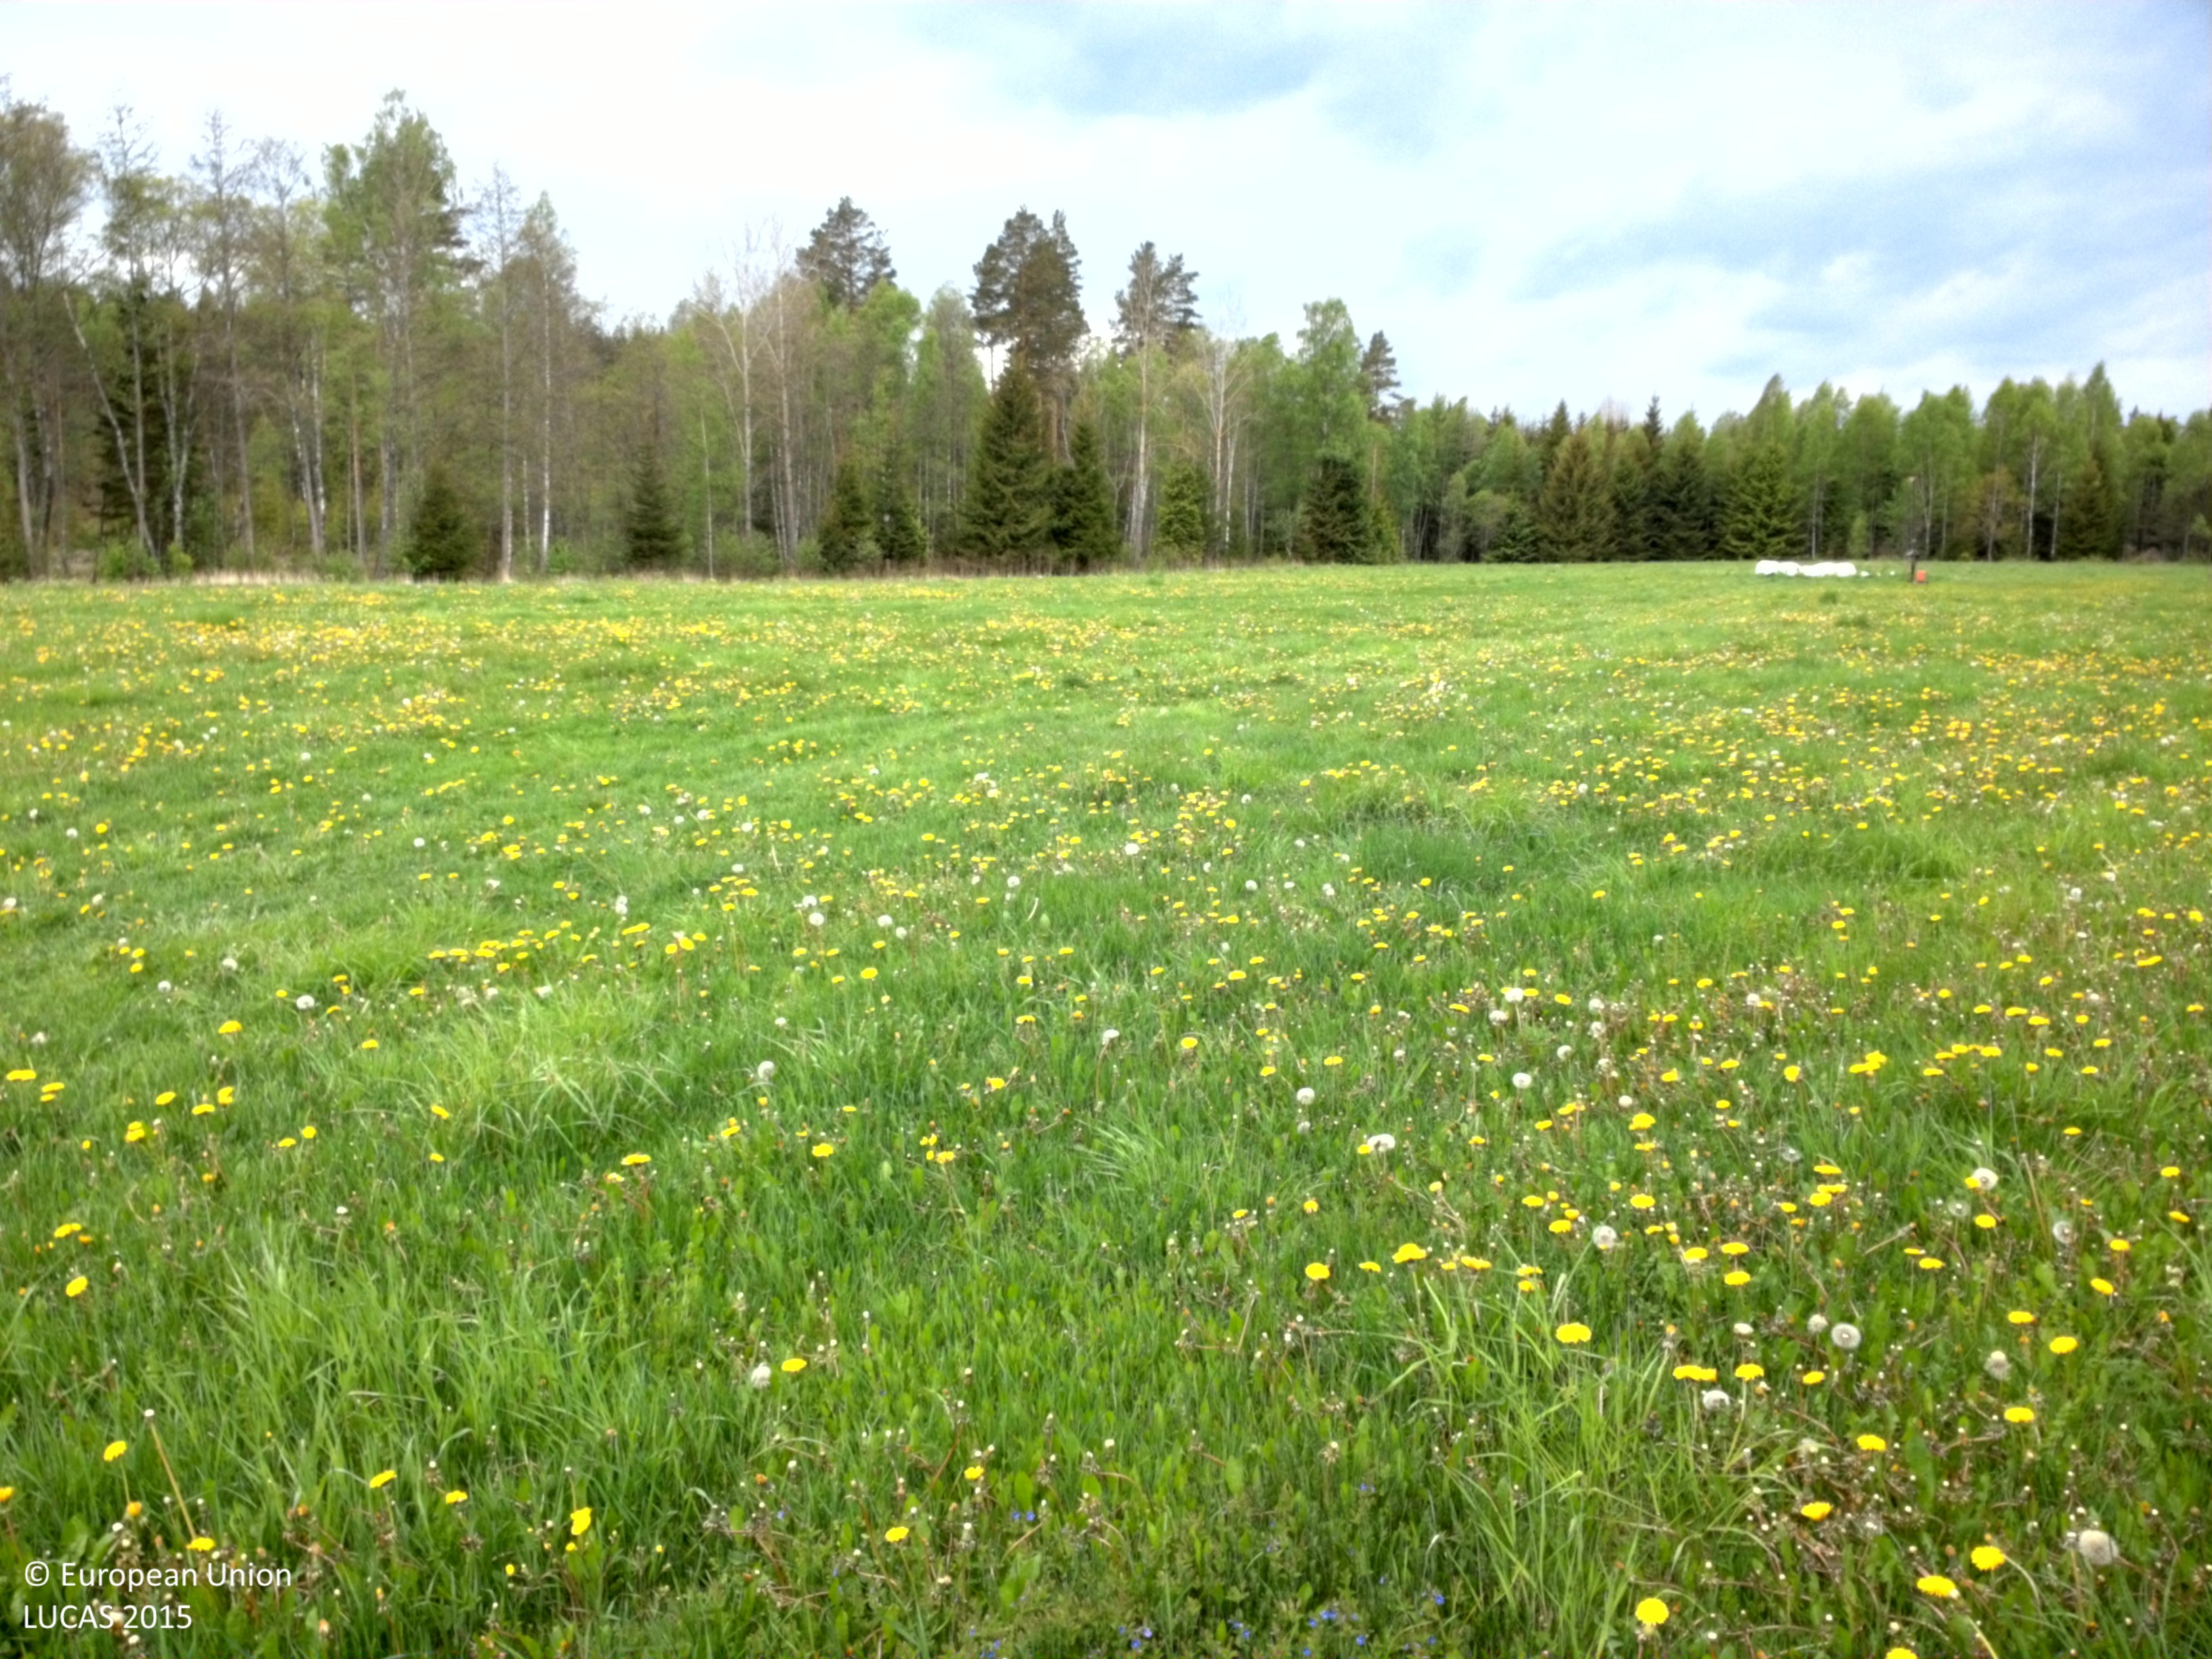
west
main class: Grassland
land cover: Grassland without tree/shrub cover
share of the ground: > 75 %
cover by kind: herbaceous plants 100 %
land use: Agriculture (excluding fallow land and kitchen gardens)
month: May
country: SE
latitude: 57.4242
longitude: 15.4423
